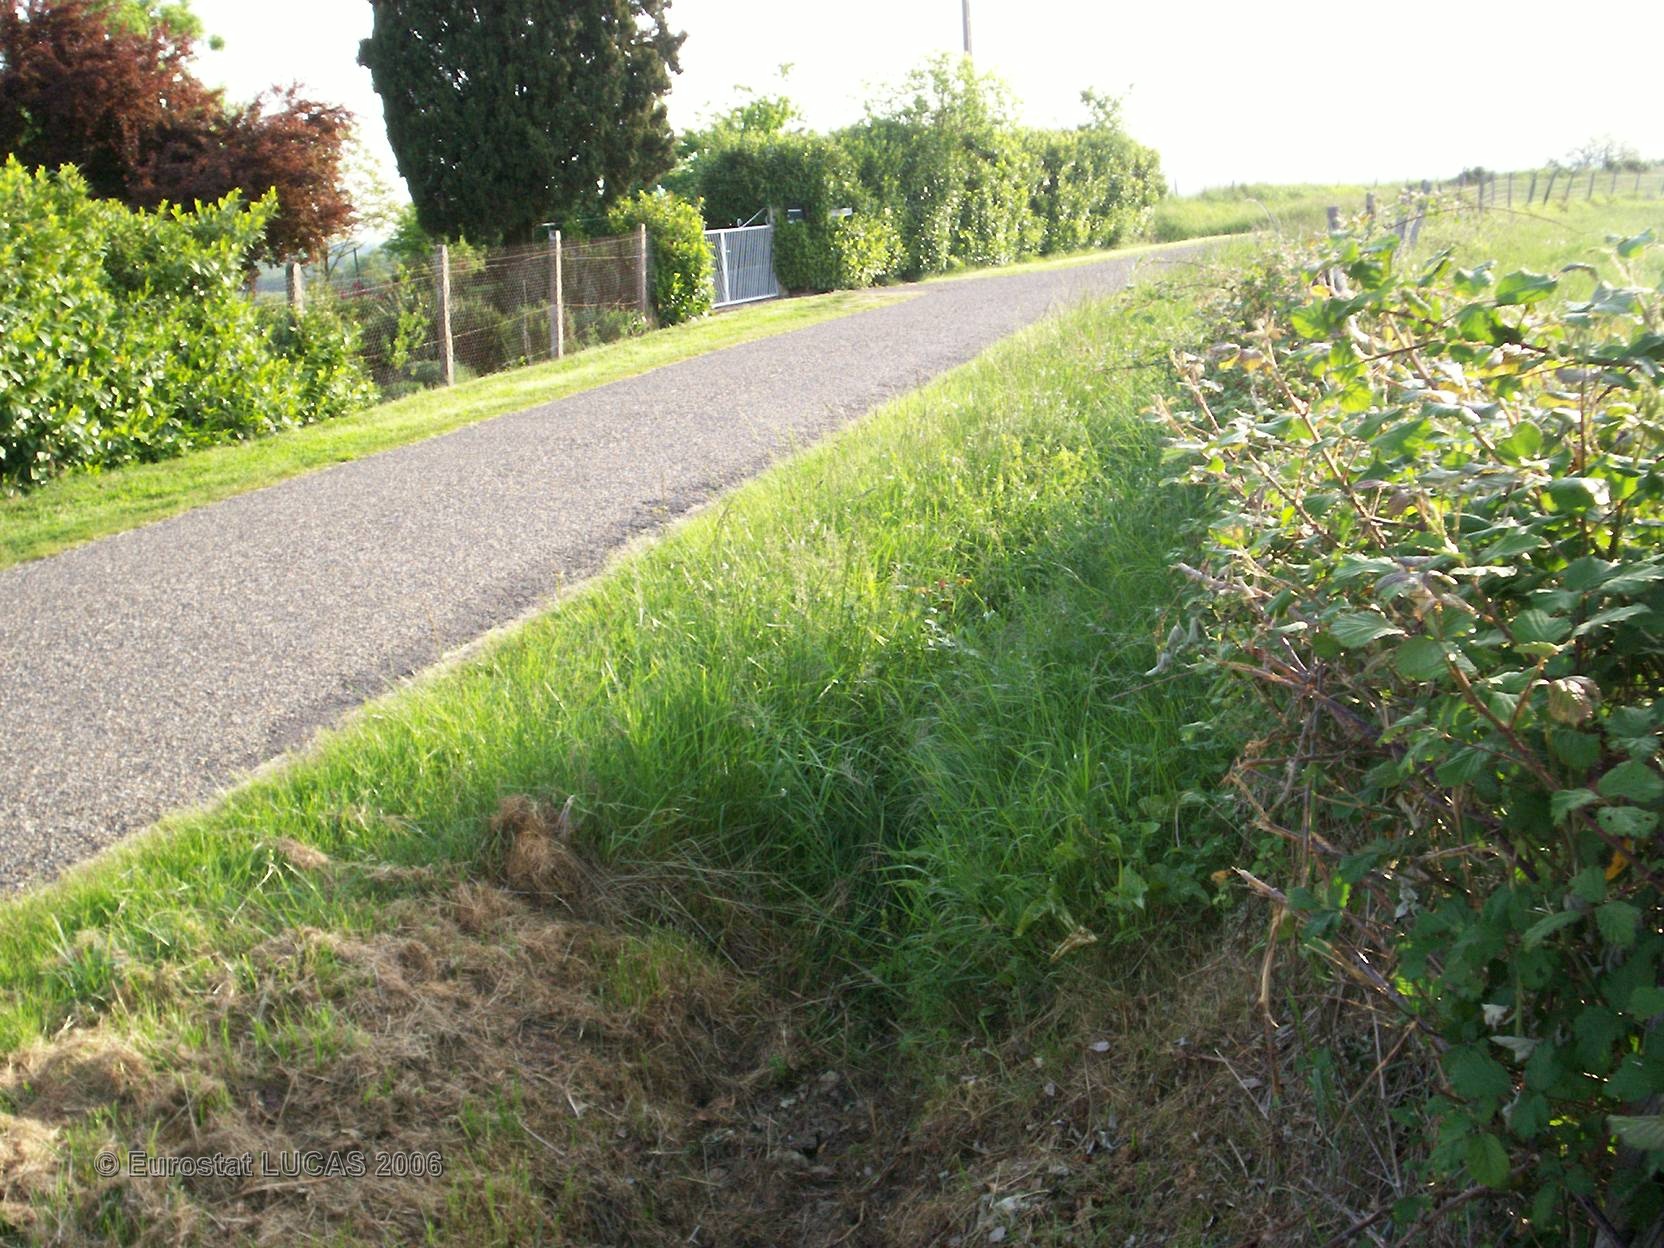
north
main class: Grassland
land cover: Grassland without tree/shrub cover
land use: Agriculture (excluding fallow land and kitchen gardens)
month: May
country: FR
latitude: 43.7401
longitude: 0.1977
